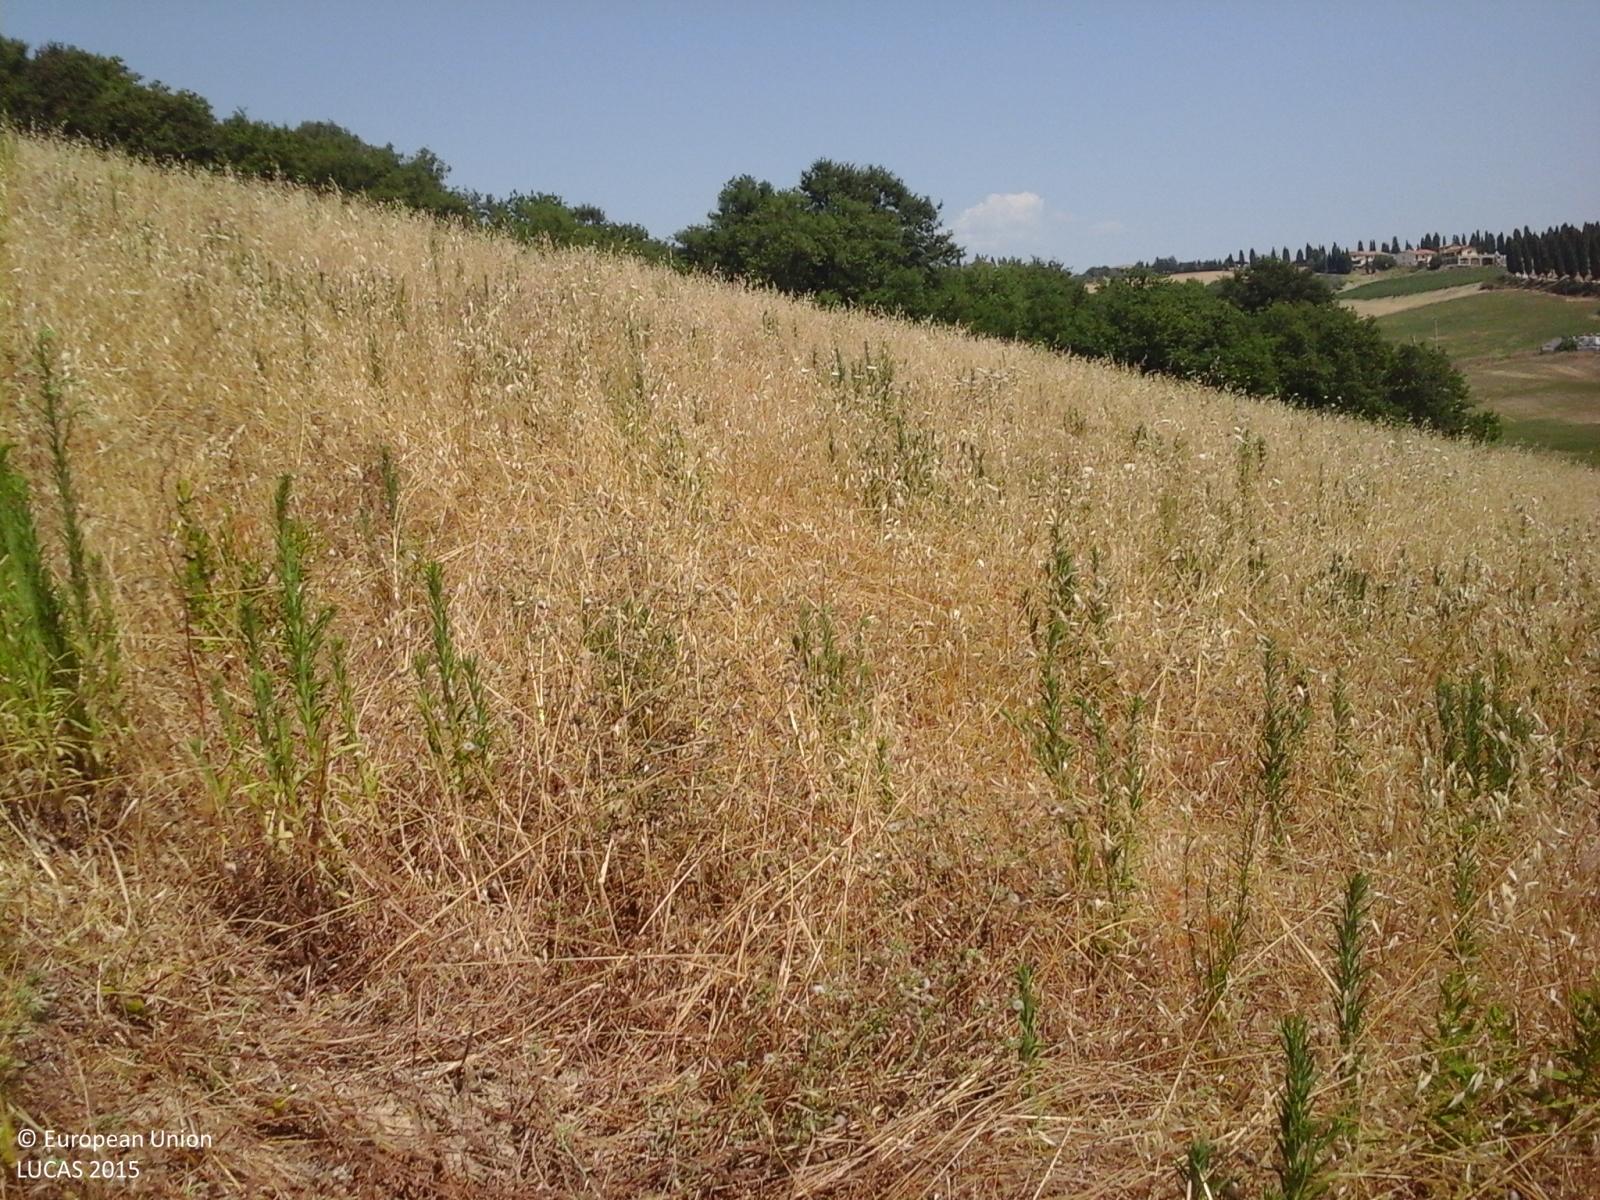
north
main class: Cropland
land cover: Oats
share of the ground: > 75 %
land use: Agriculture (excluding fallow land and kitchen gardens)
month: July
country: IT
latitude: 43.0936
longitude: 11.5556
